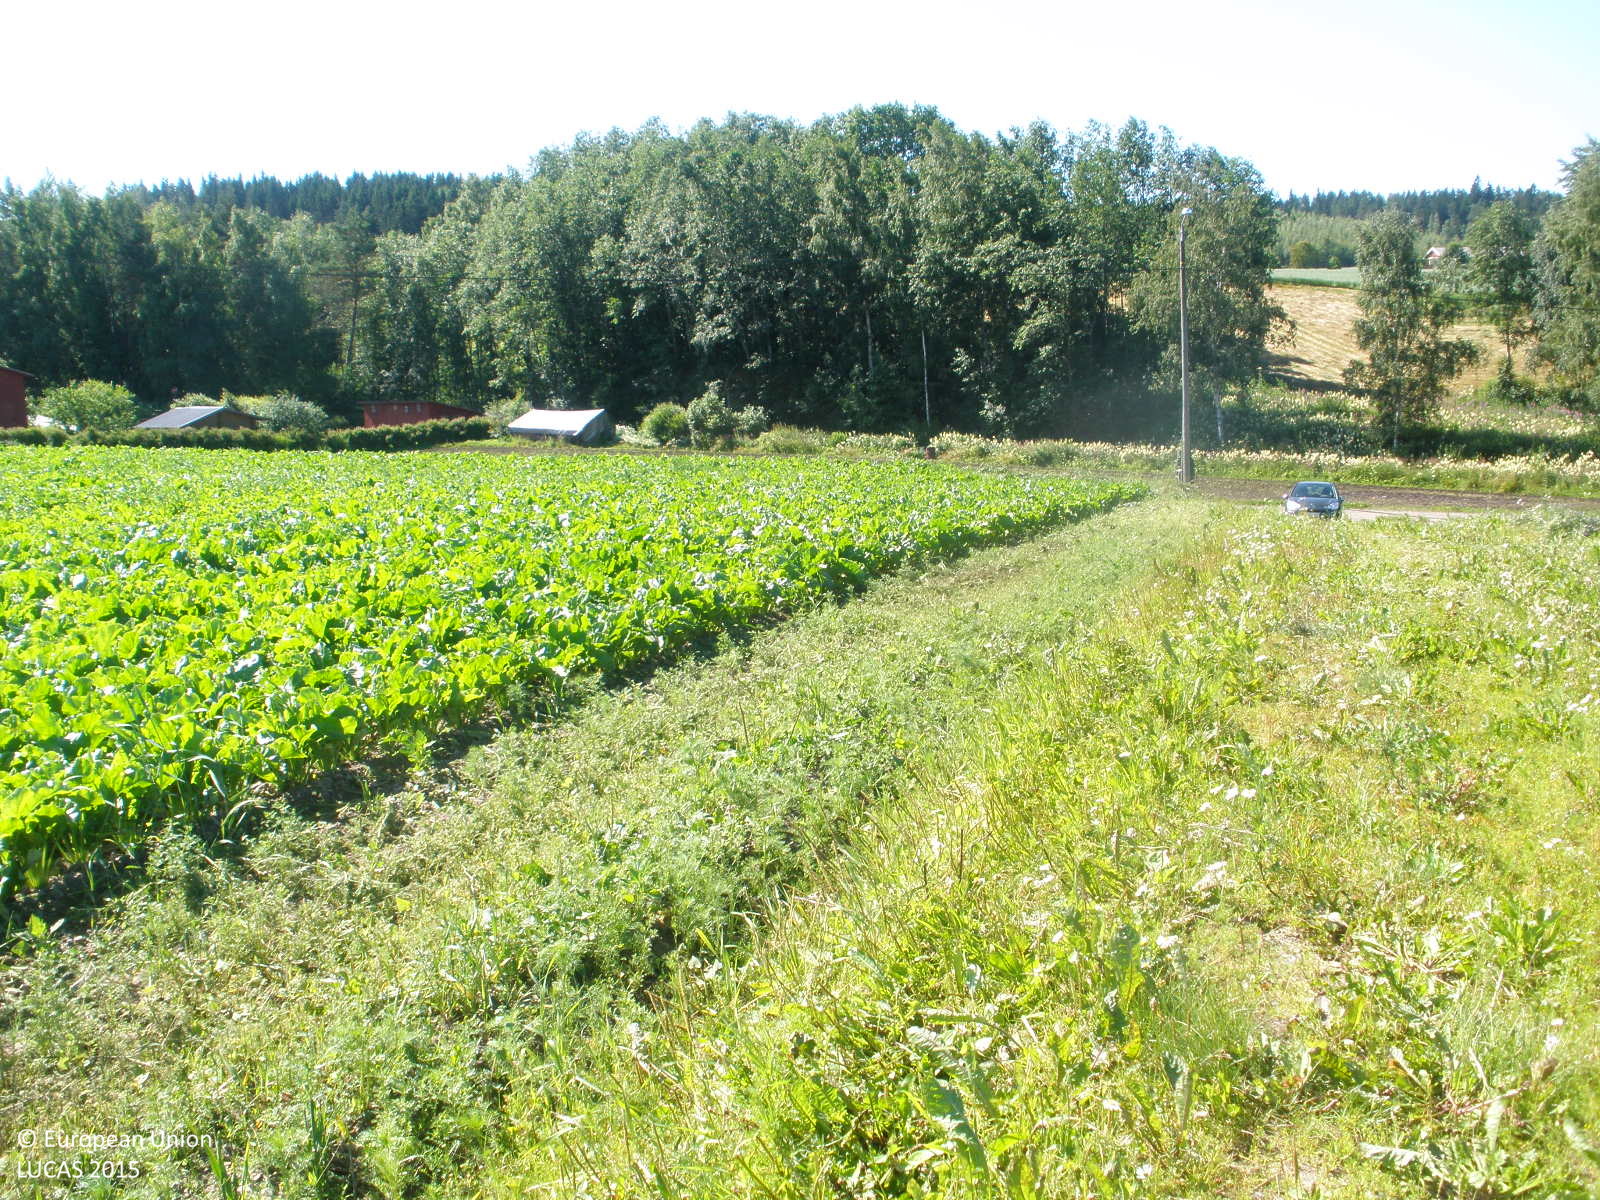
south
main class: Artificial land
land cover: Non built-up linear features
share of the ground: > 75 %
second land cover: Grassland without tree/shrub cover
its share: > 75 %
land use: Road transport
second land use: Agriculture (excluding fallow land and kitchen gardens)
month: July
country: FI
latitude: 61.0717
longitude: 24.9186
